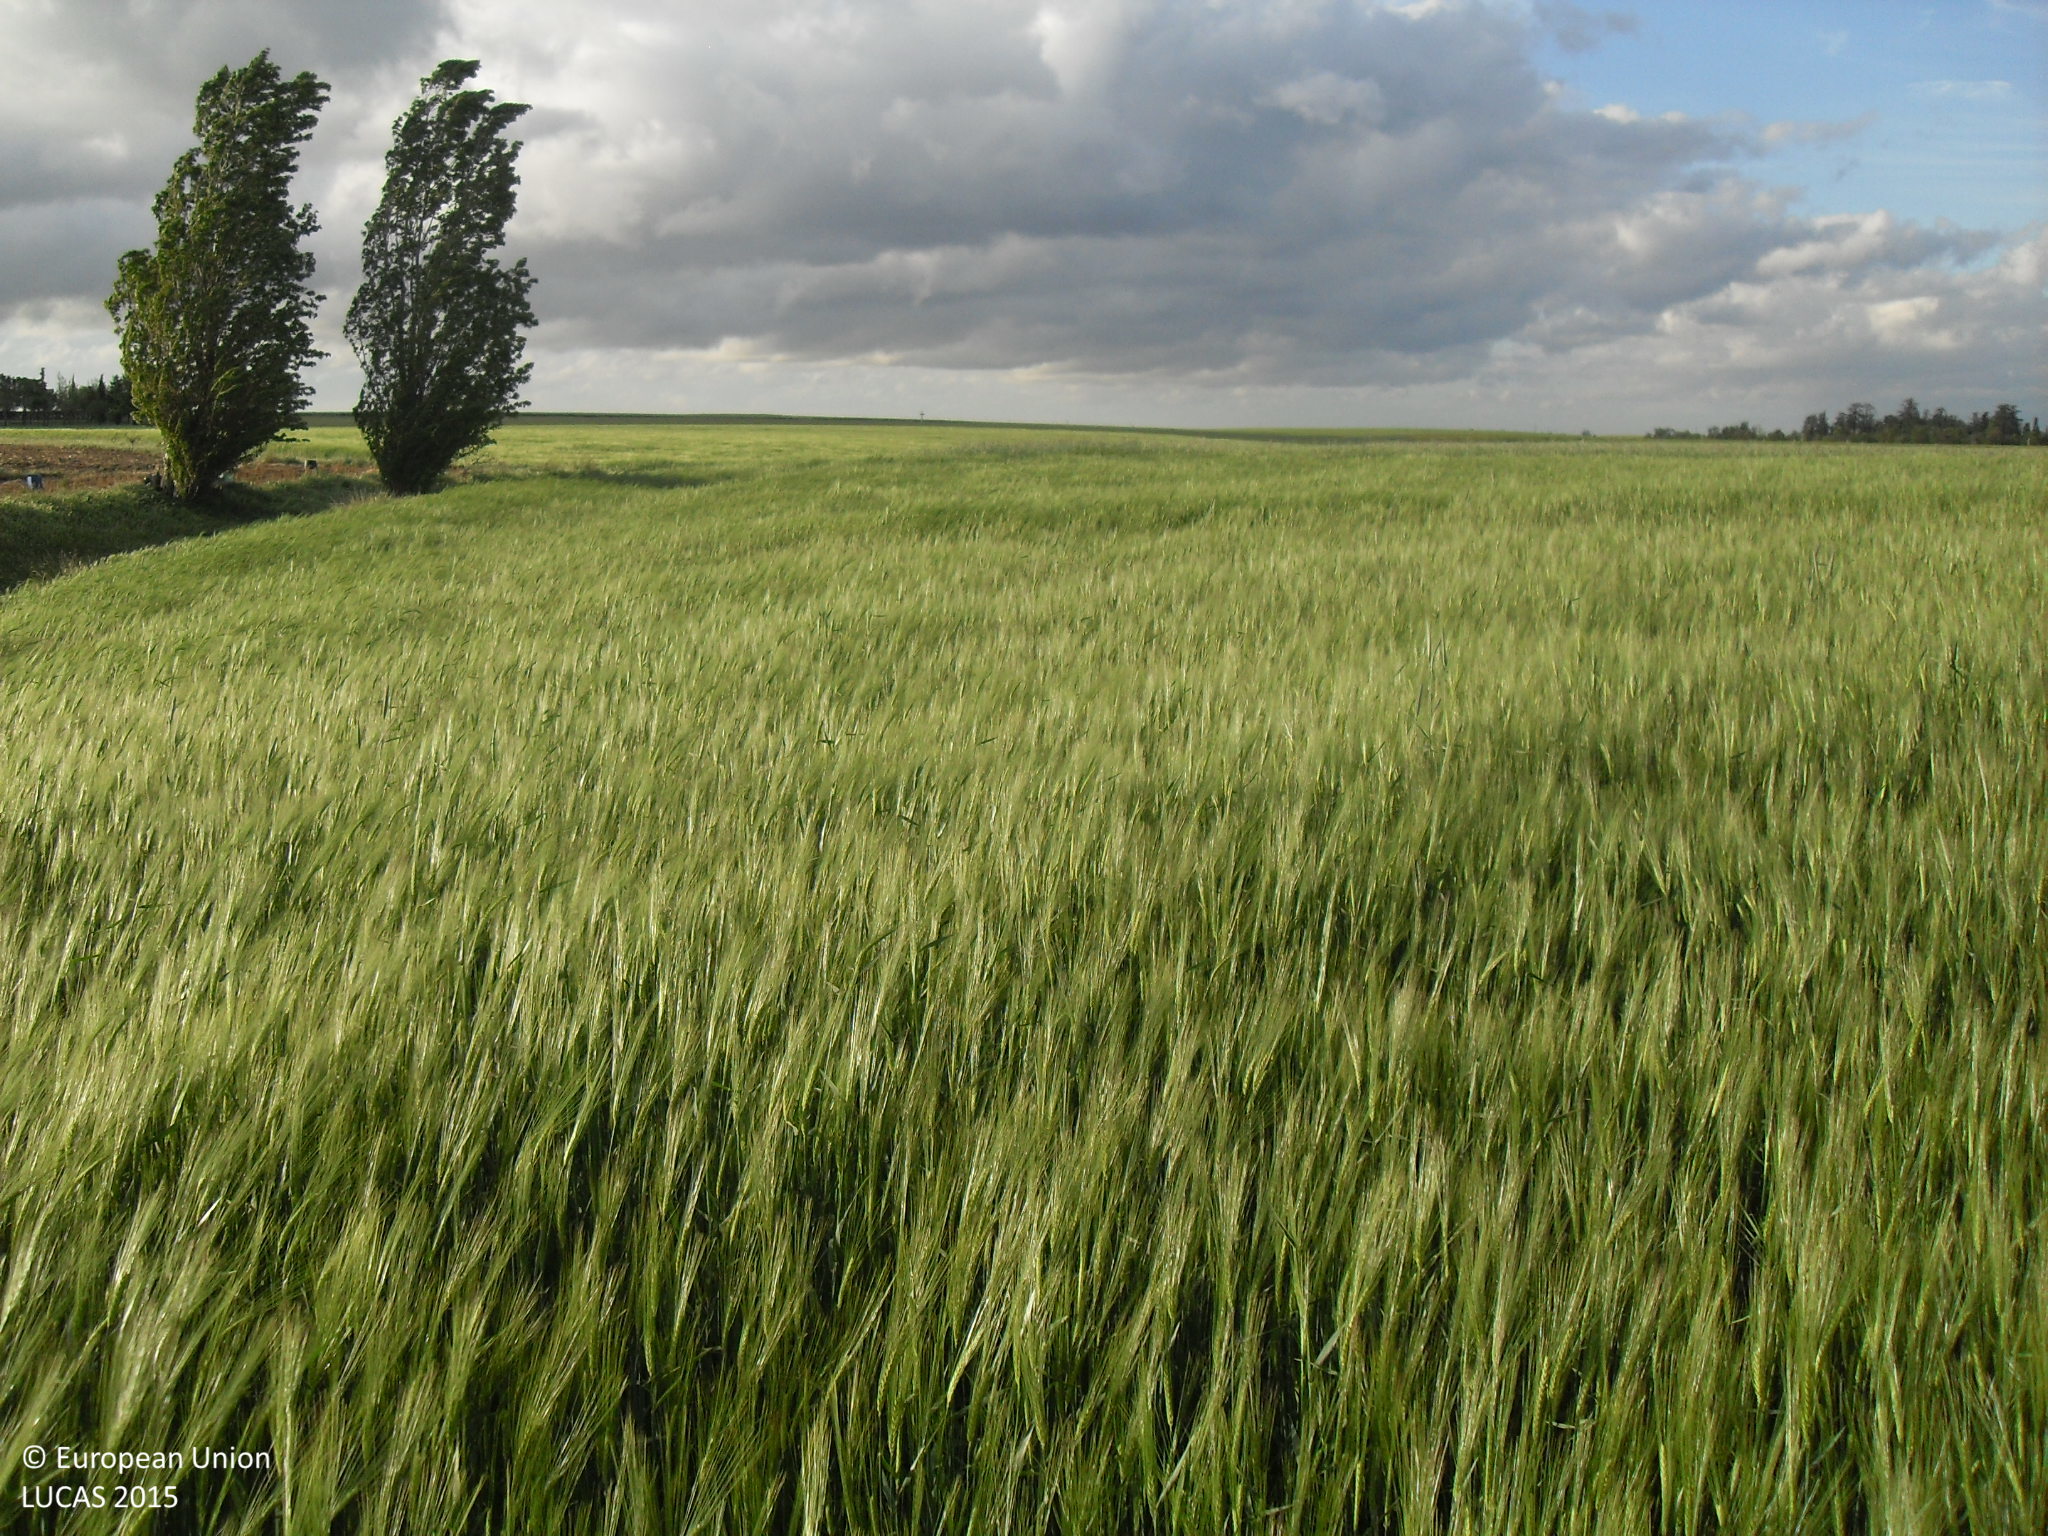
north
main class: Cropland
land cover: Barley
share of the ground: > 75 %
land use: Agriculture (excluding fallow land and kitchen gardens)
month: May
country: ES
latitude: 40.9713
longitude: -5.1718
